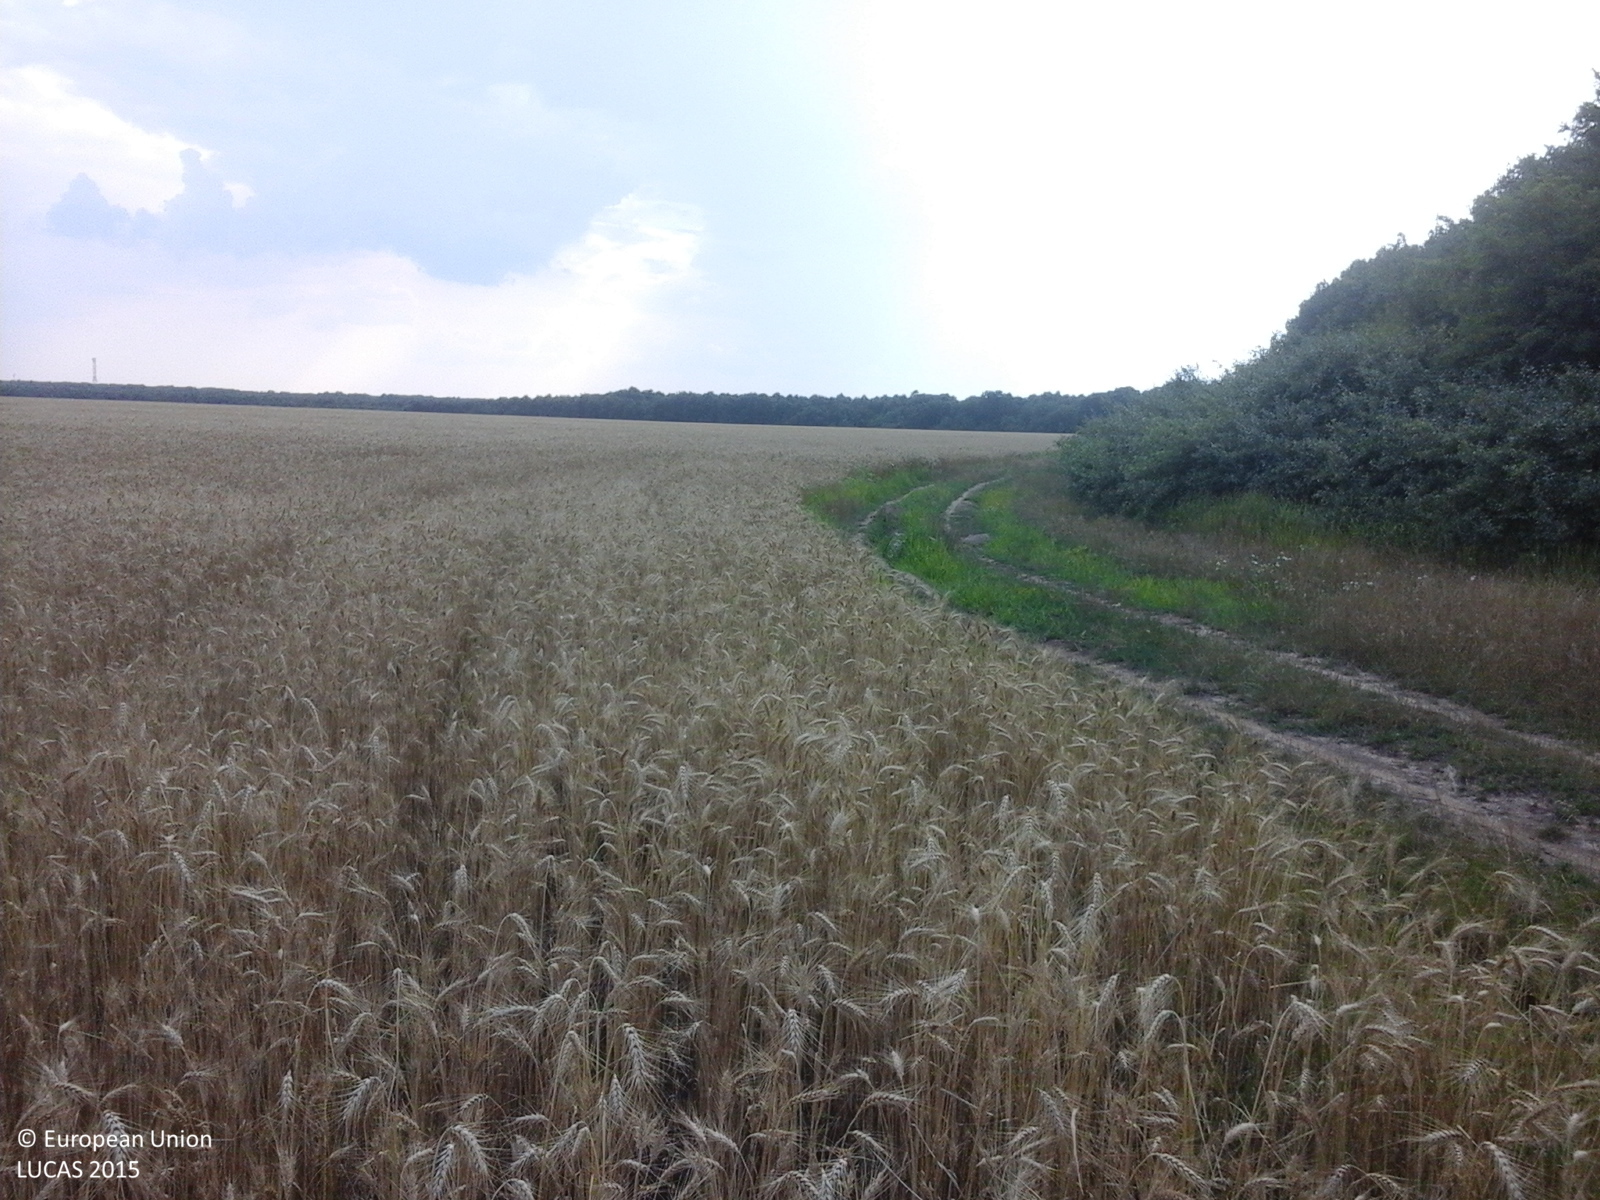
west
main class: Cropland
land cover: Common wheat
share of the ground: > 75 %
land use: Agriculture (excluding fallow land and kitchen gardens)
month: July
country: RO
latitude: 44.2093
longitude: 25.8276
